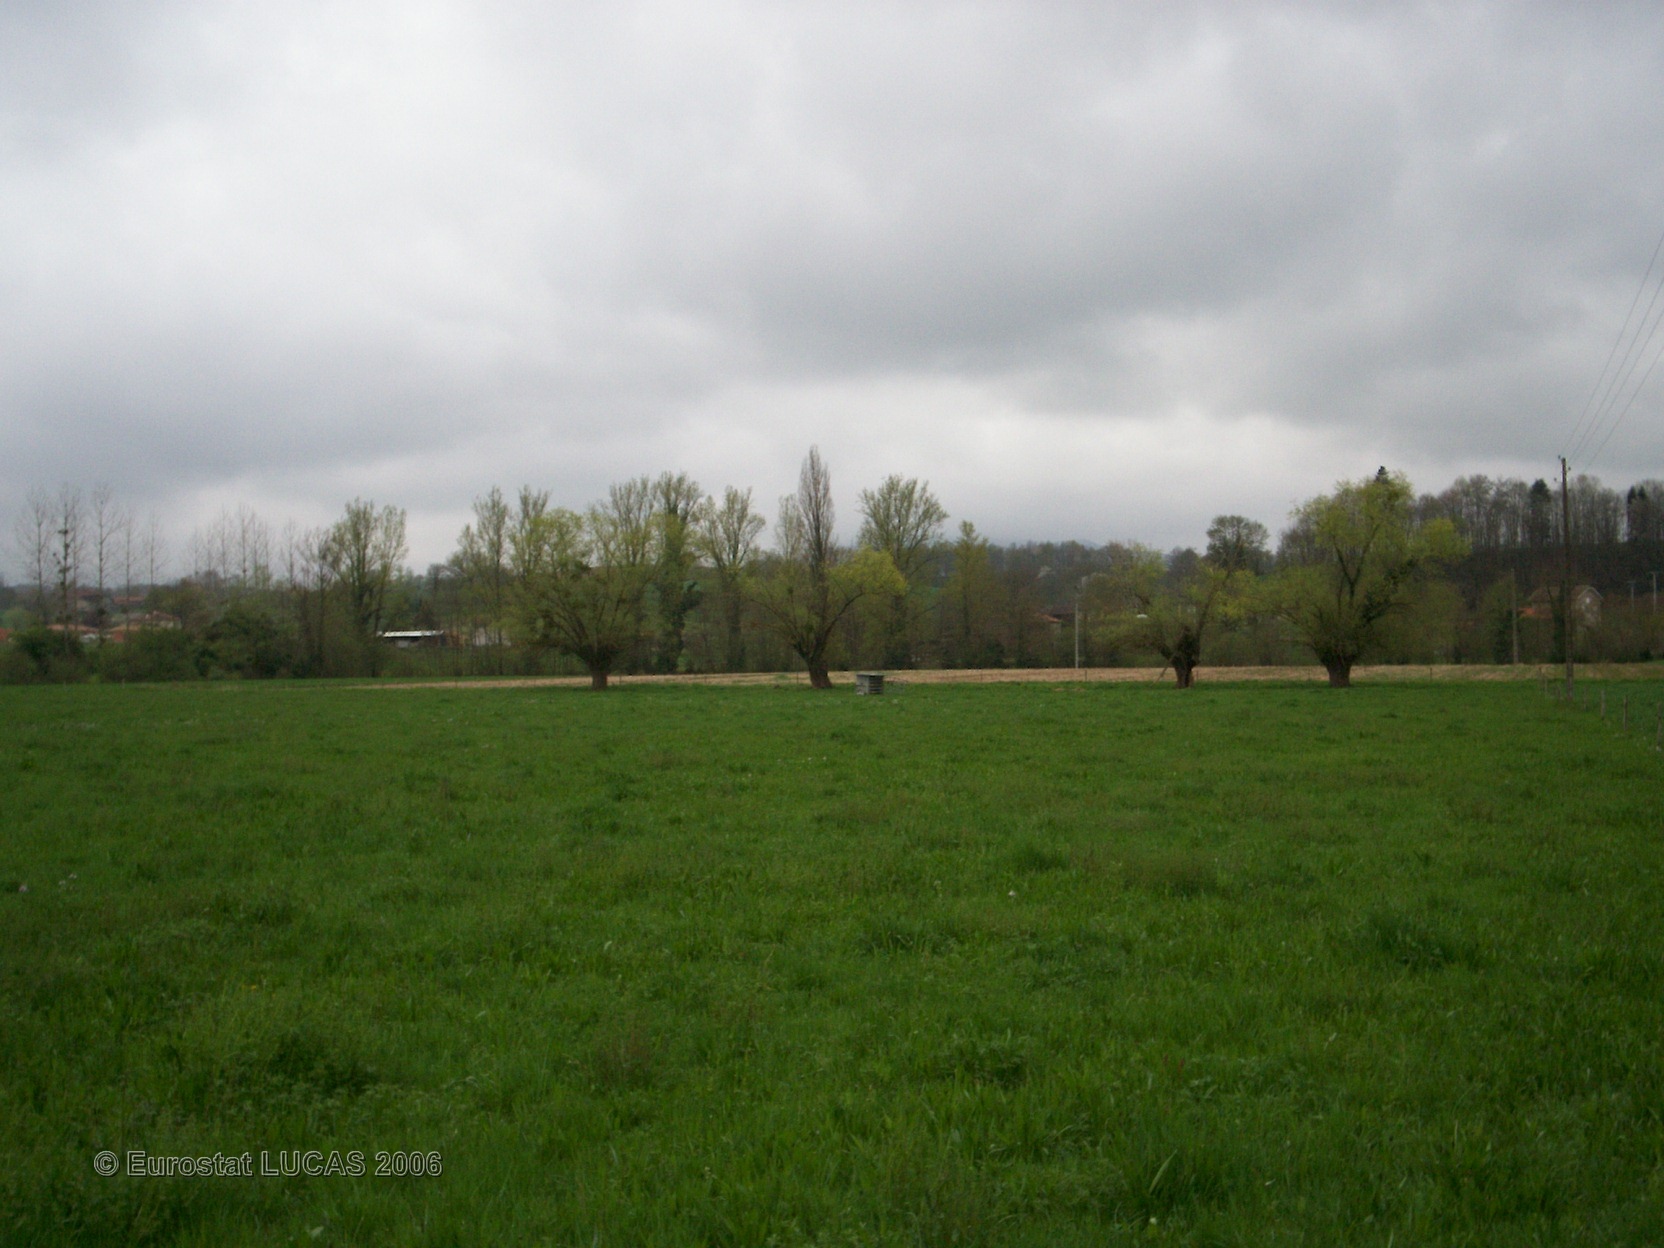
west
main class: Grassland
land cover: Grassland without tree/shrub cover
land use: Agriculture (excluding fallow land and kitchen gardens)
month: April
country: FR
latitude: 43.0455
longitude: 0.9316
